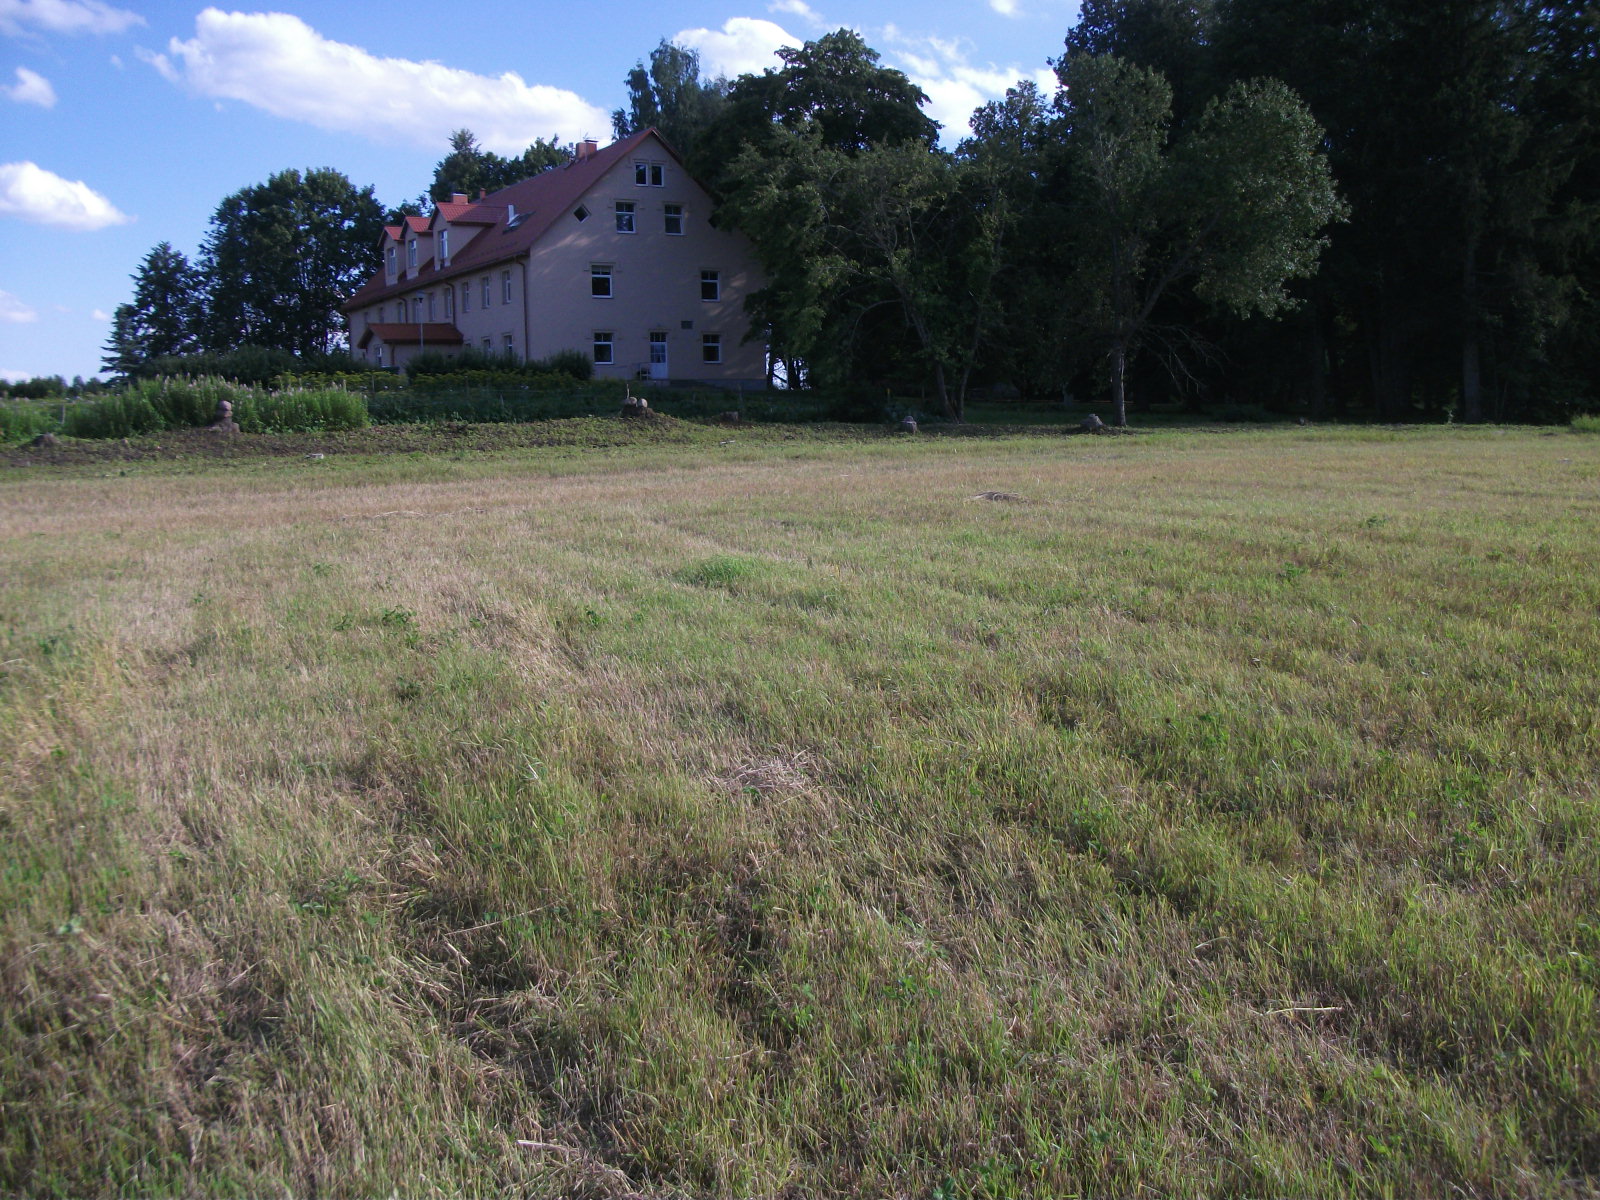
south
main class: Grassland
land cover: Grassland without tree/shrub cover
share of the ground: > 75 %
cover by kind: herbaceous plants 100 %
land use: Agriculture (excluding fallow land and kitchen gardens)
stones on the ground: < 10 %
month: August
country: LV
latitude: 57.0316
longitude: 26.5746
